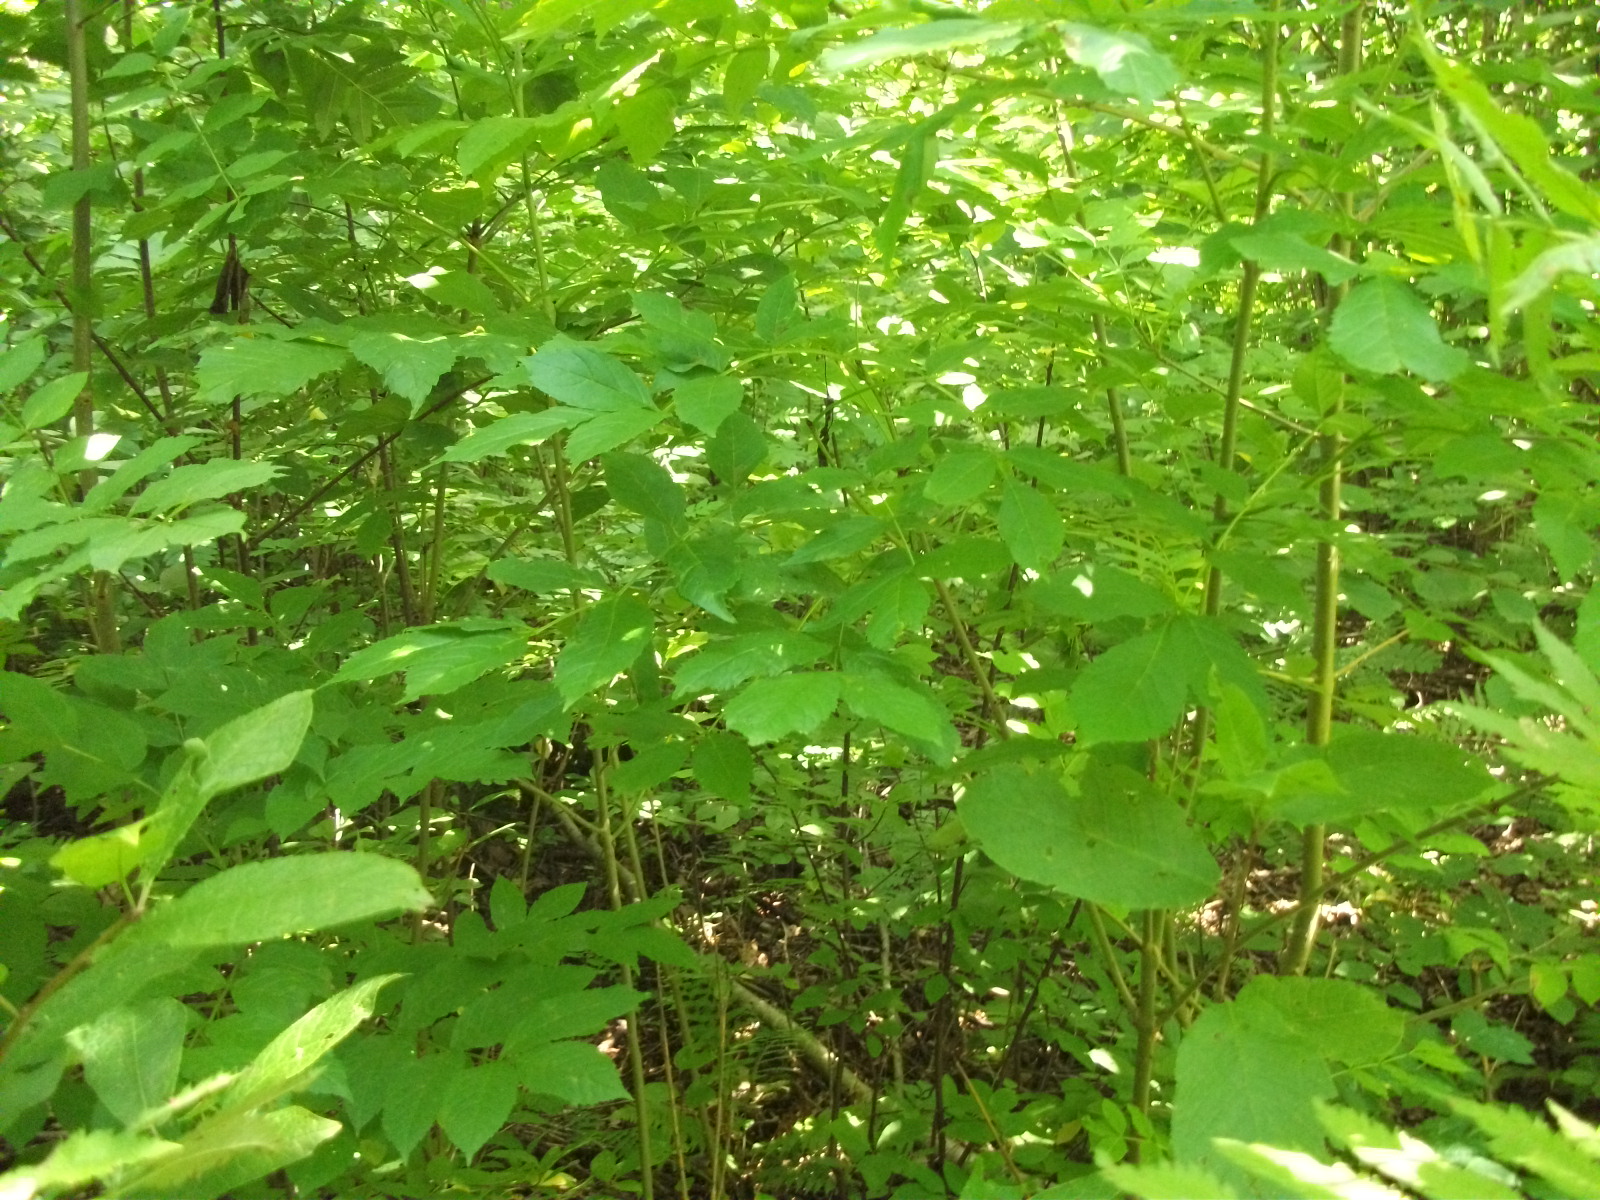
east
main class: Woodland
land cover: Broadleaved woodland
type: non-riverine alder, birch or aspen forest
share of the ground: > 75 %
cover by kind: broadleaved forest trees 100 %
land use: Forestry
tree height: > 5 m
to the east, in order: Broadleaved woodland; Grassland without tree/shrub cover
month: July
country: LV
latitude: 57.0295
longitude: 26.3021
